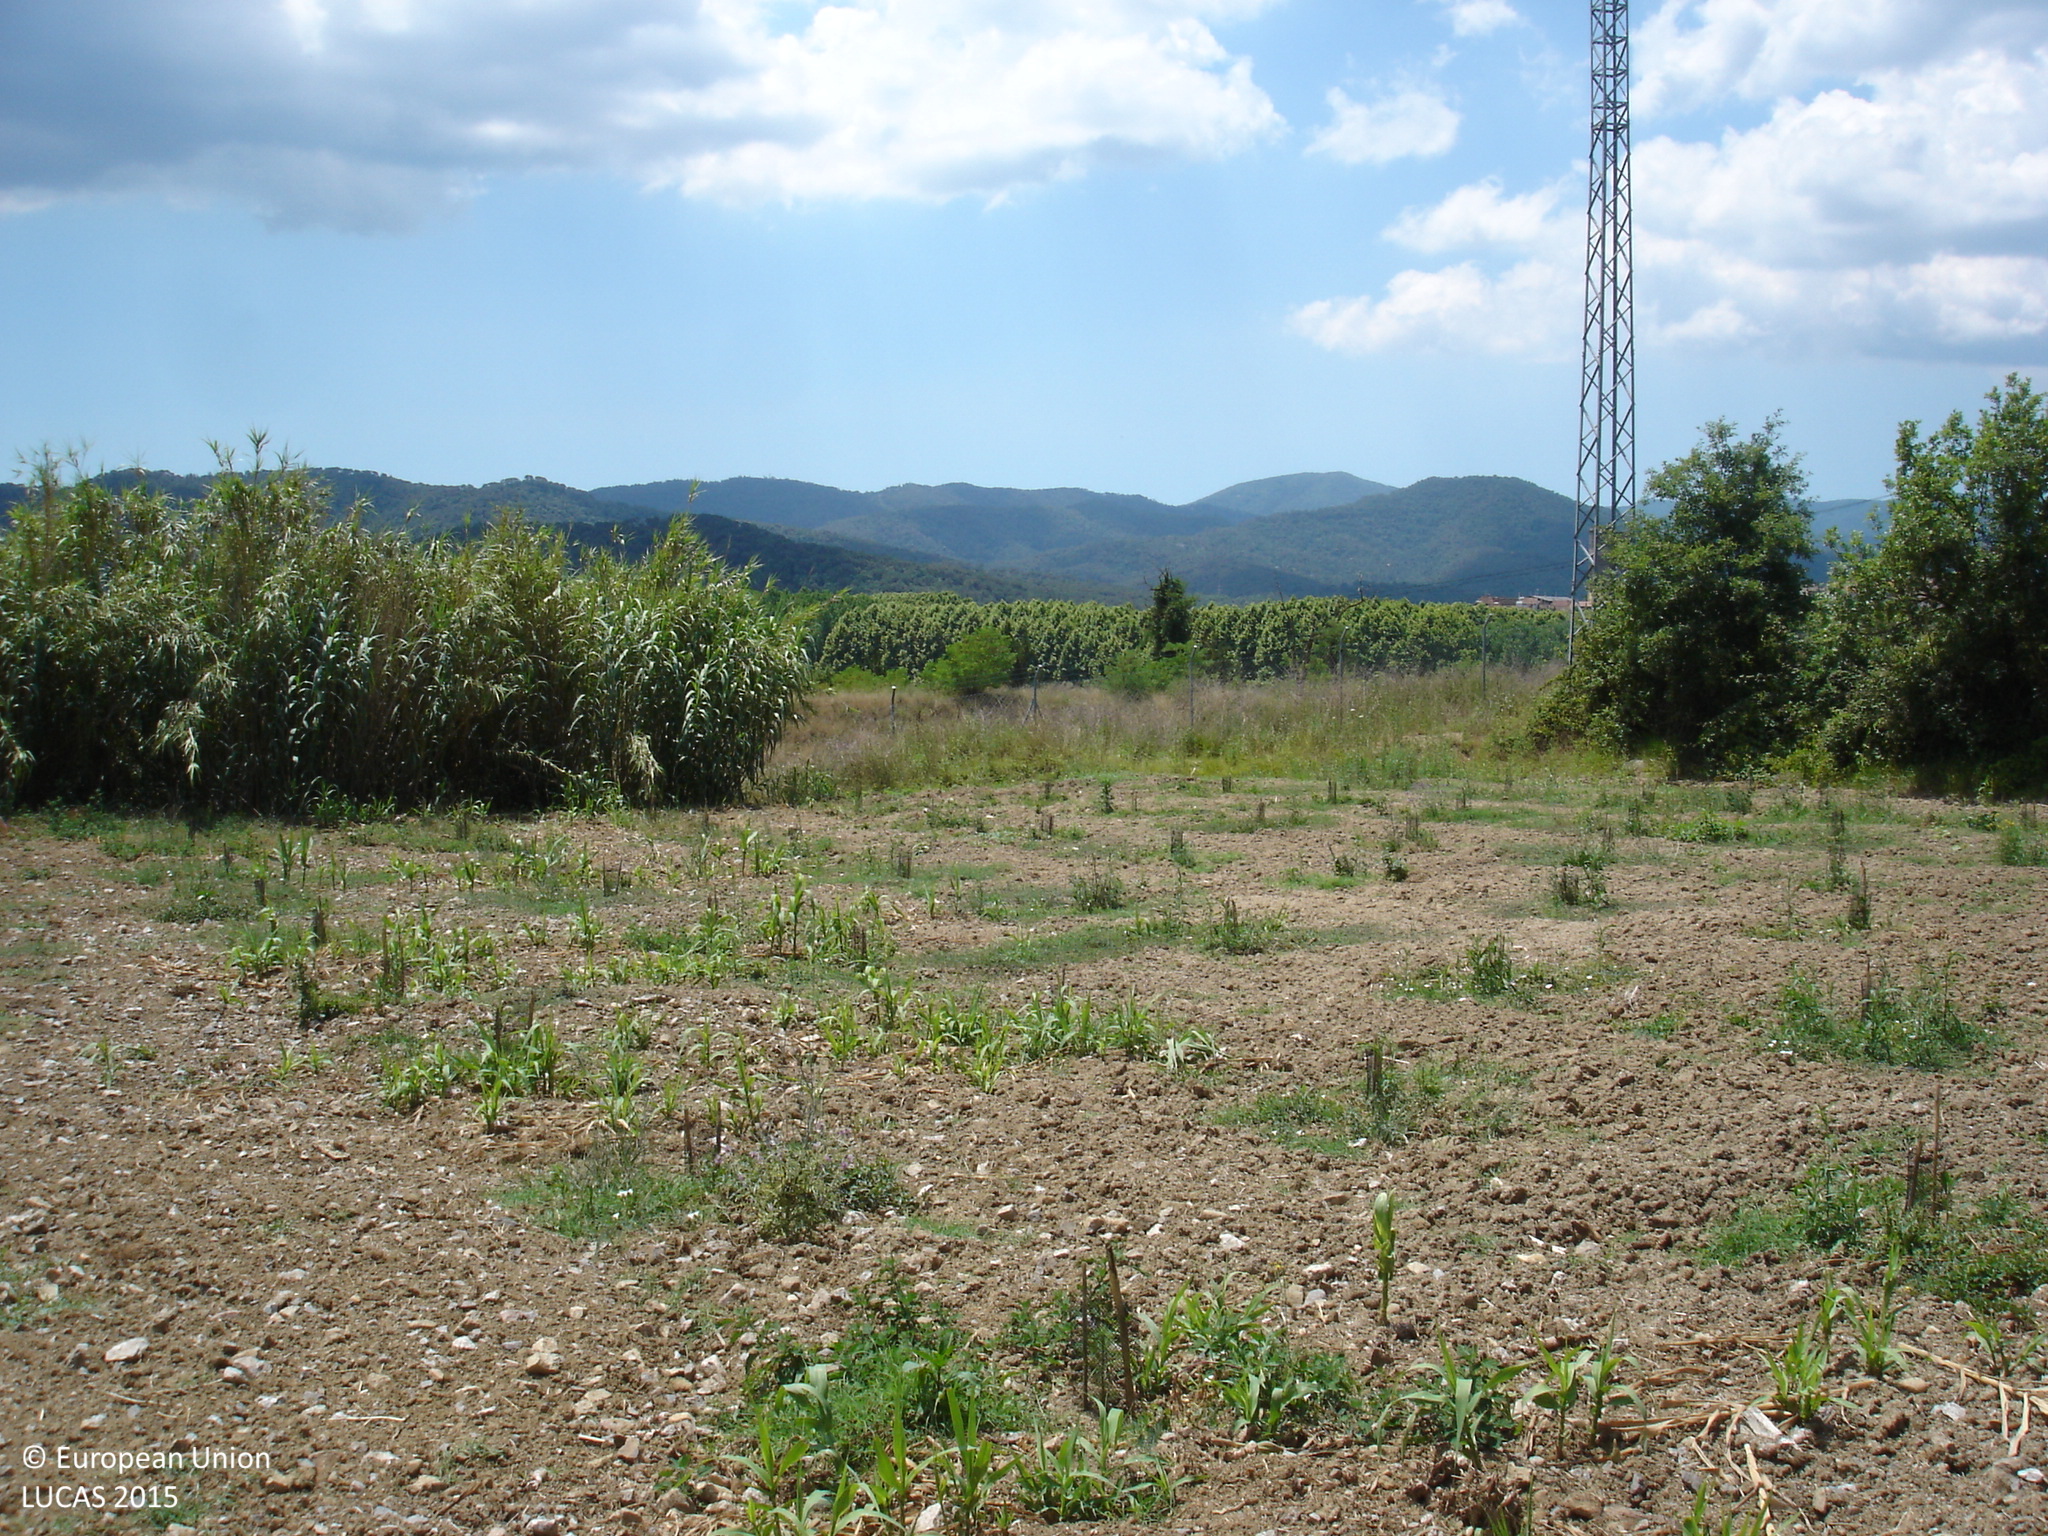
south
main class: Grassland
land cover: Grassland with sparse tree/shrub cover
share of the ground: 10 - 25 %
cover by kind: consolidated bare surface 80 %, herbaceous plants 15 %, coniferous forest trees 5 %
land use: Forestry
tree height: < 5 m
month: June
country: ES
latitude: 41.7517
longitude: 2.6446
